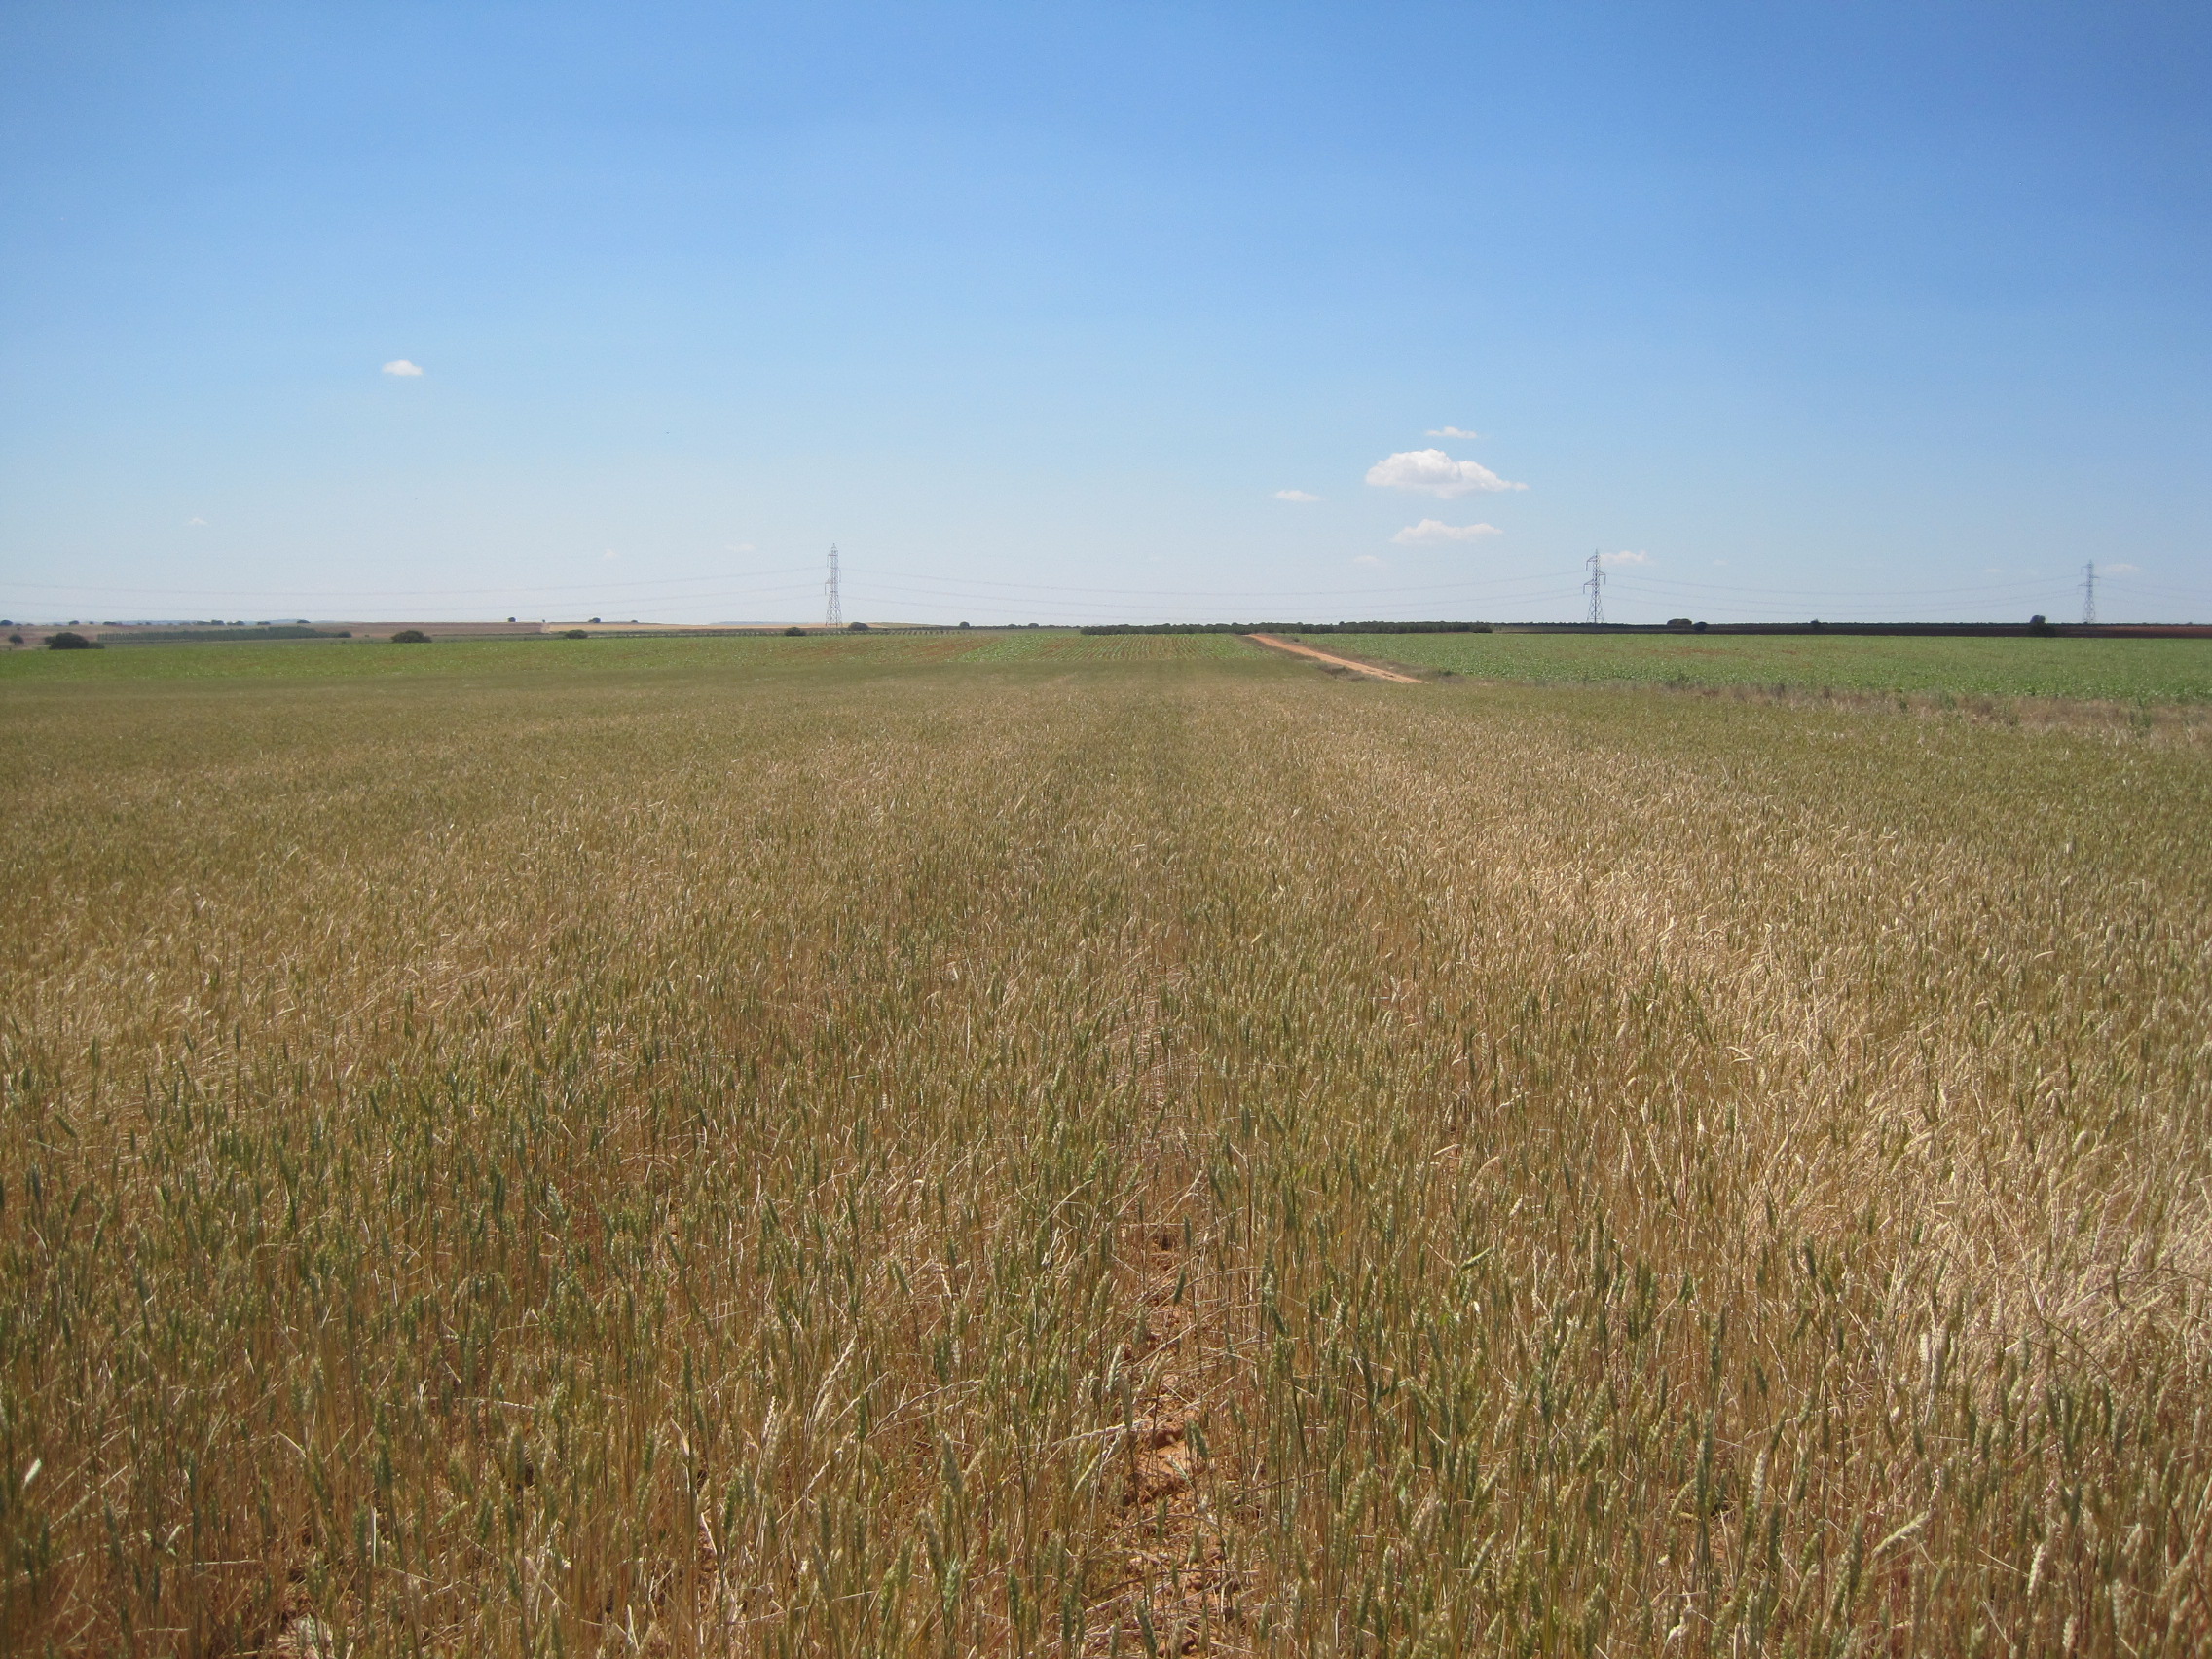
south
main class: Cropland
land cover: Common wheat
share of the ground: > 75 %
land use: Agriculture (excluding fallow land and kitchen gardens)
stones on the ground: 10 - 25 %
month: June
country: ES
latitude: 41.8015
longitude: -5.3802
